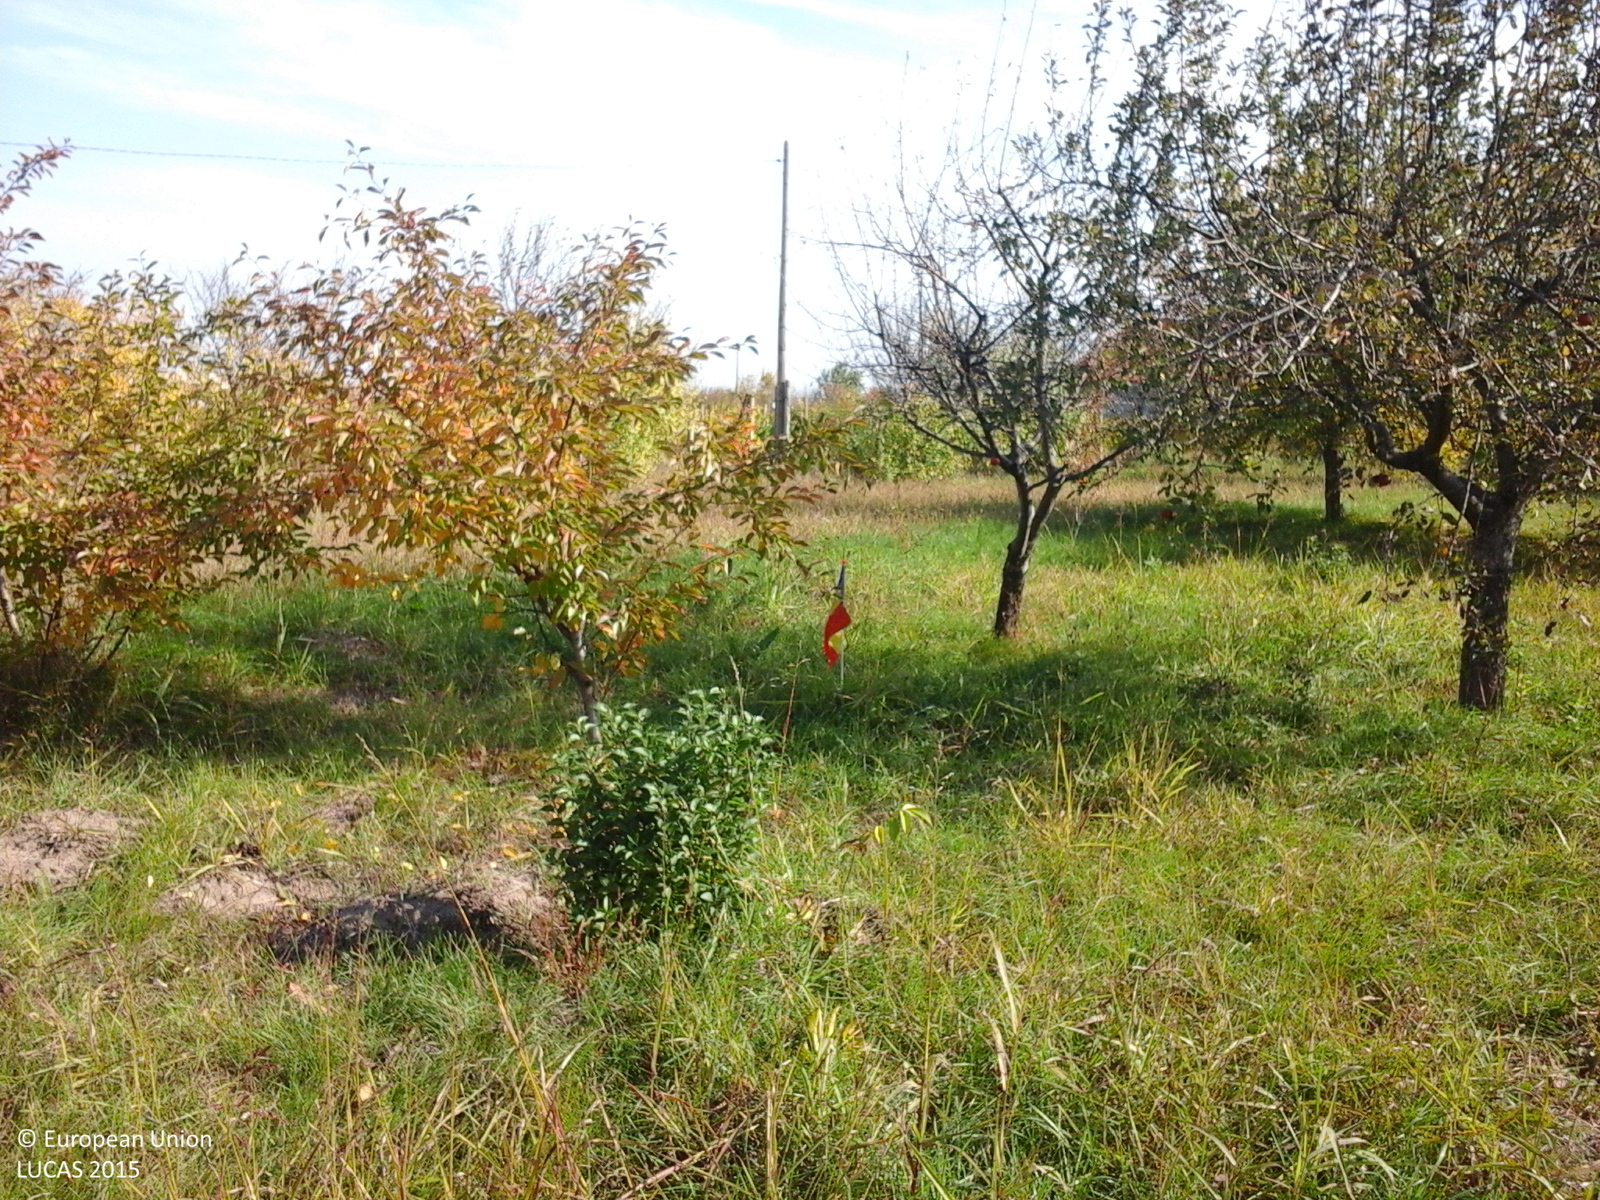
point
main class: Cropland
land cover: Apple fruit
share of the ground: 50 - 75 %
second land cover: Grassland without tree/shrub cover
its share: > 75 %
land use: Agriculture (excluding fallow land and kitchen gardens)
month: October
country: RO
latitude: 45.6039
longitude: 27.1056
